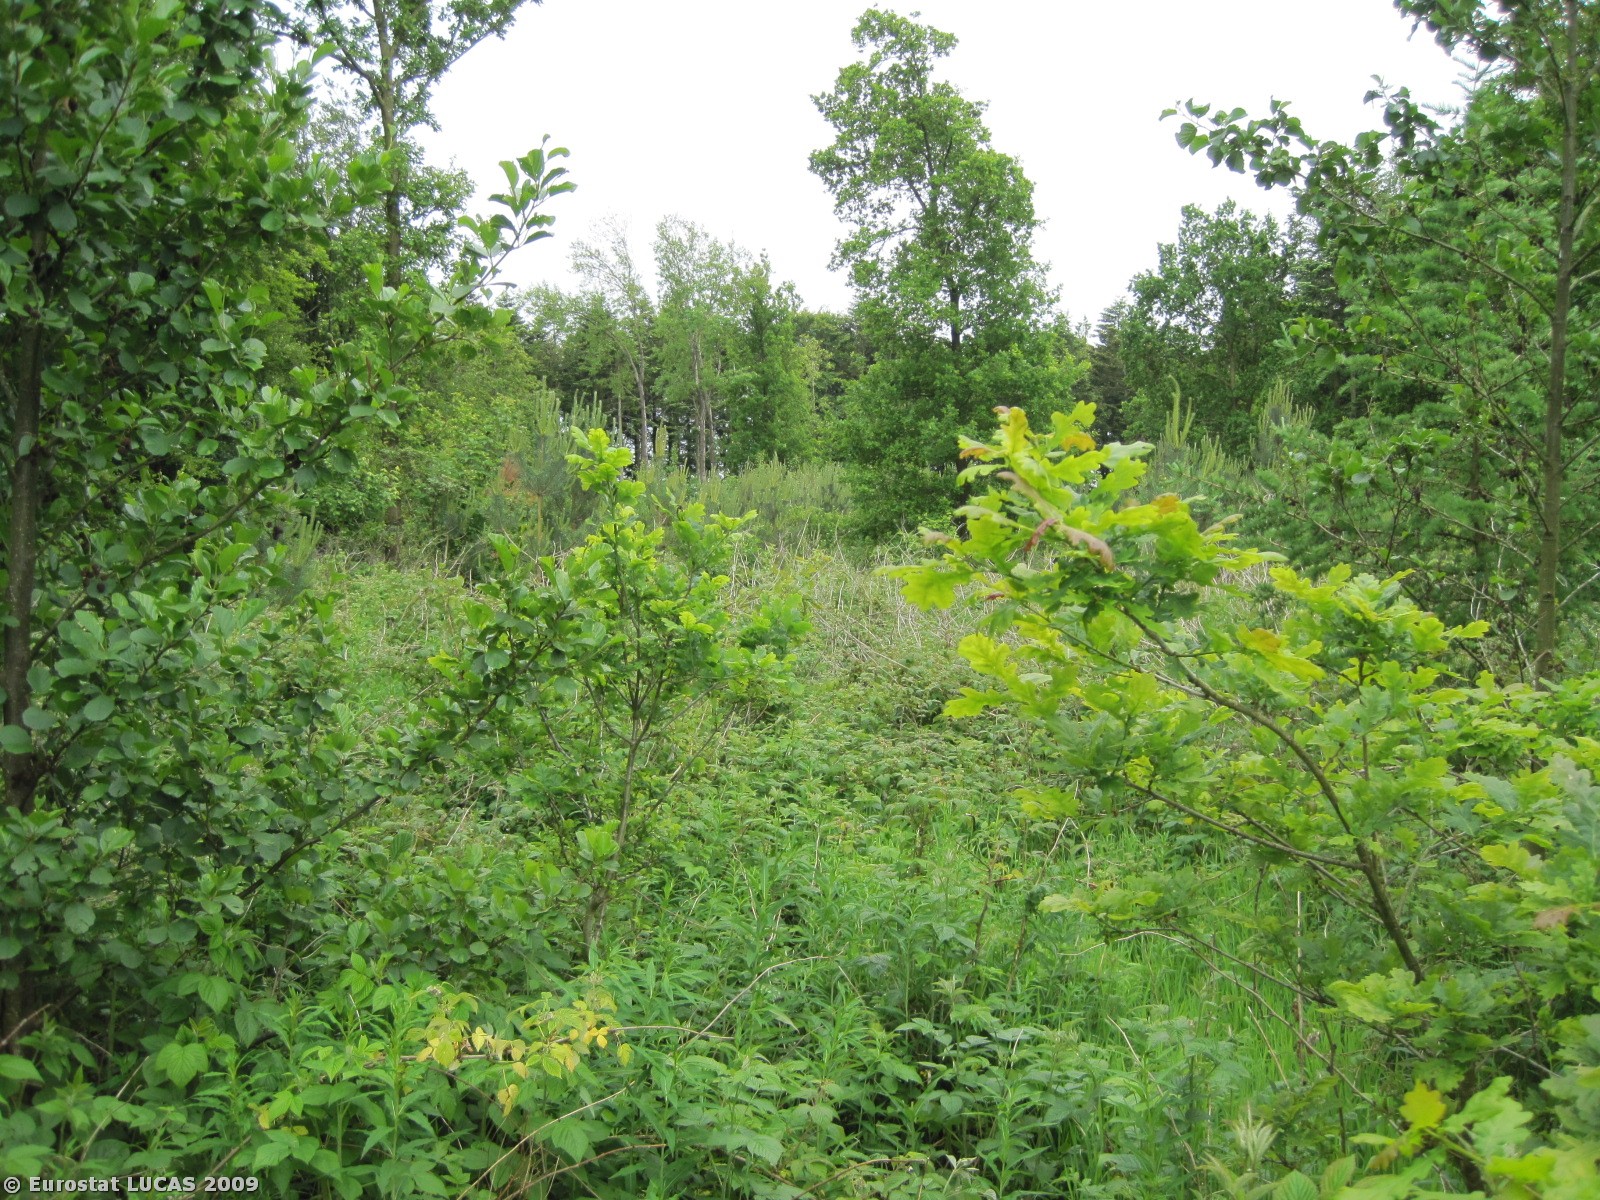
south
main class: Shrubland
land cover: Shrubland with sparse tree cover
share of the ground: > 75 %
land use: Unused
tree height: < 5 m
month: June
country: DK
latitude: 57.3563
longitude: 10.0166
